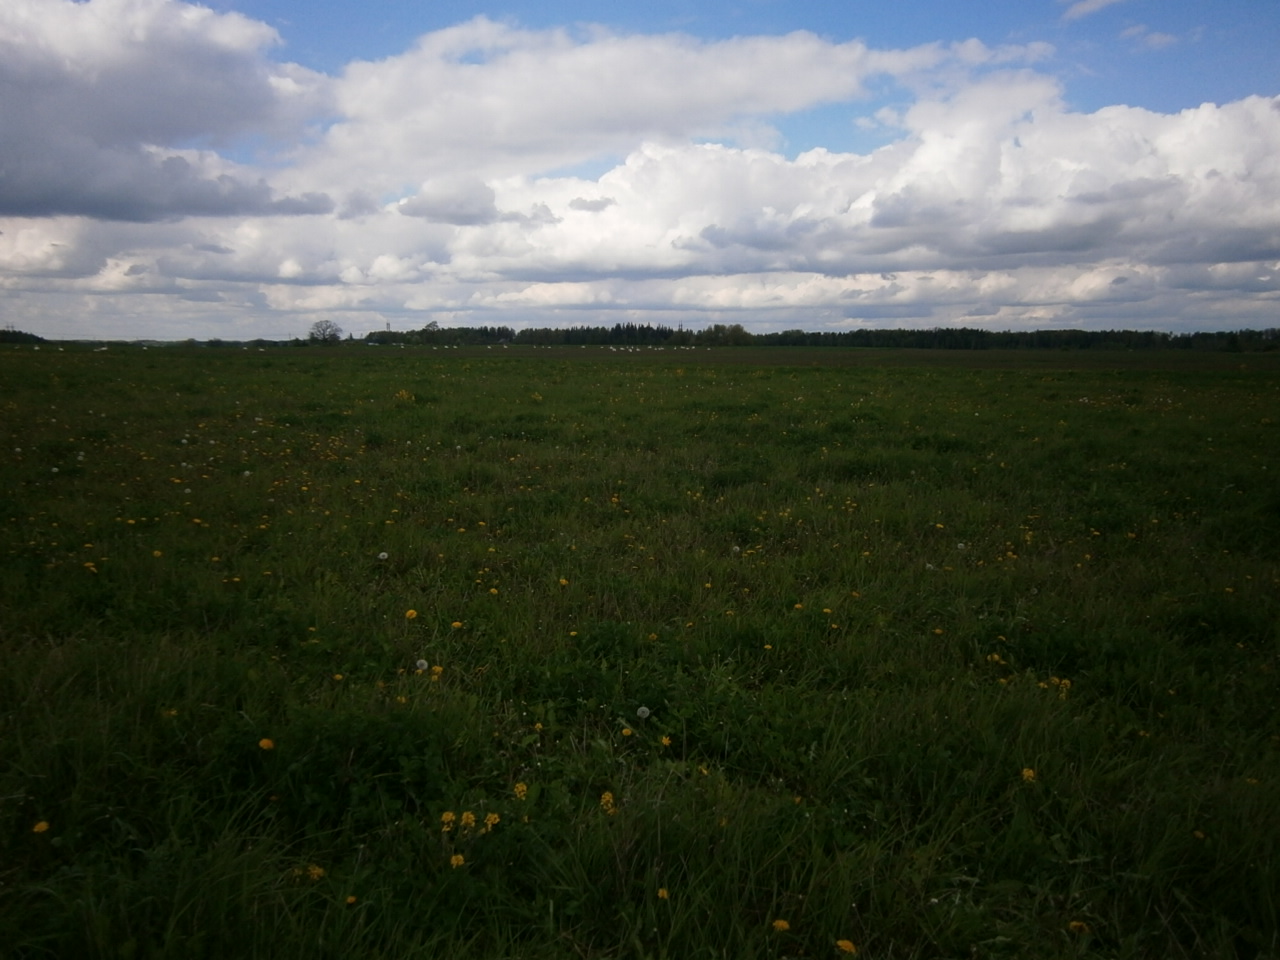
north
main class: Grassland
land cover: Grassland without tree/shrub cover
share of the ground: > 75 %
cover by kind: herbaceous plants 100 %
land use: Agriculture (excluding fallow land and kitchen gardens)
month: May
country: LV
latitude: 56.6433
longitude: 22.3662
